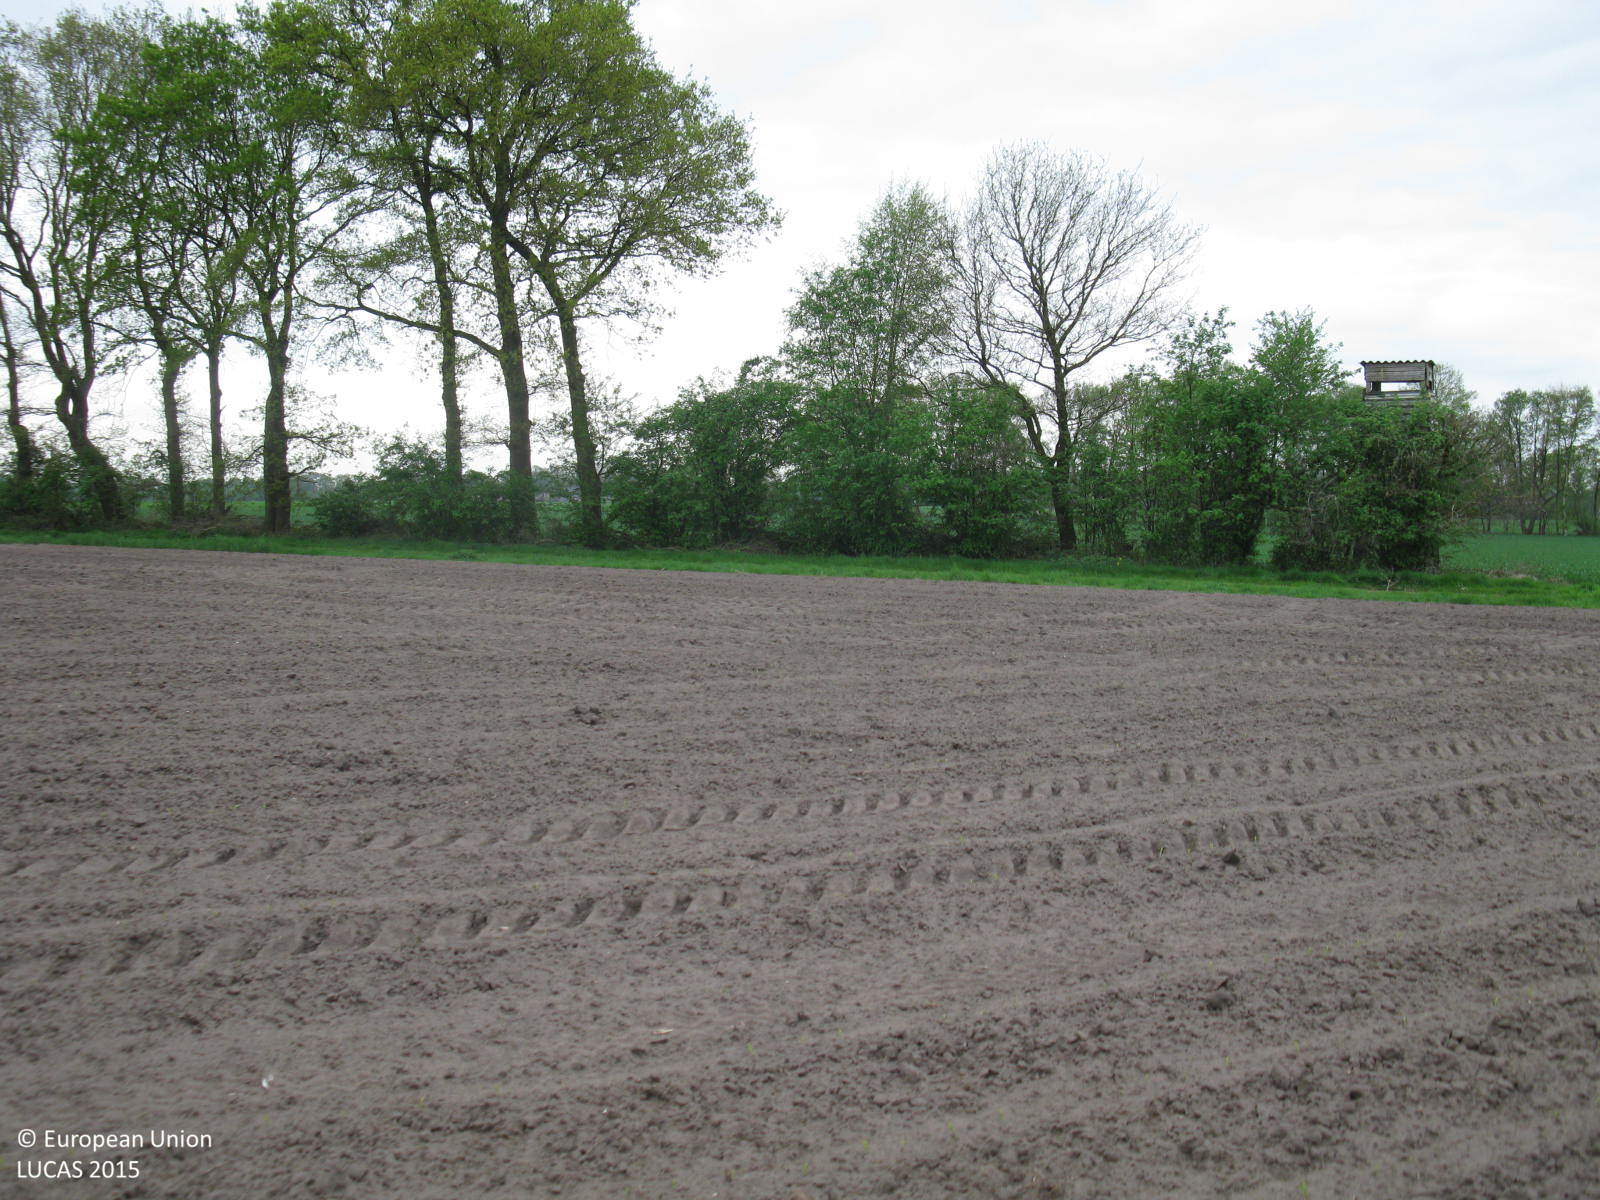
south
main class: Cropland
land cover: Maize
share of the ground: < 10 %
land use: Agriculture (excluding fallow land and kitchen gardens)
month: May
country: DE
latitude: 52.8265
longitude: 7.9080
